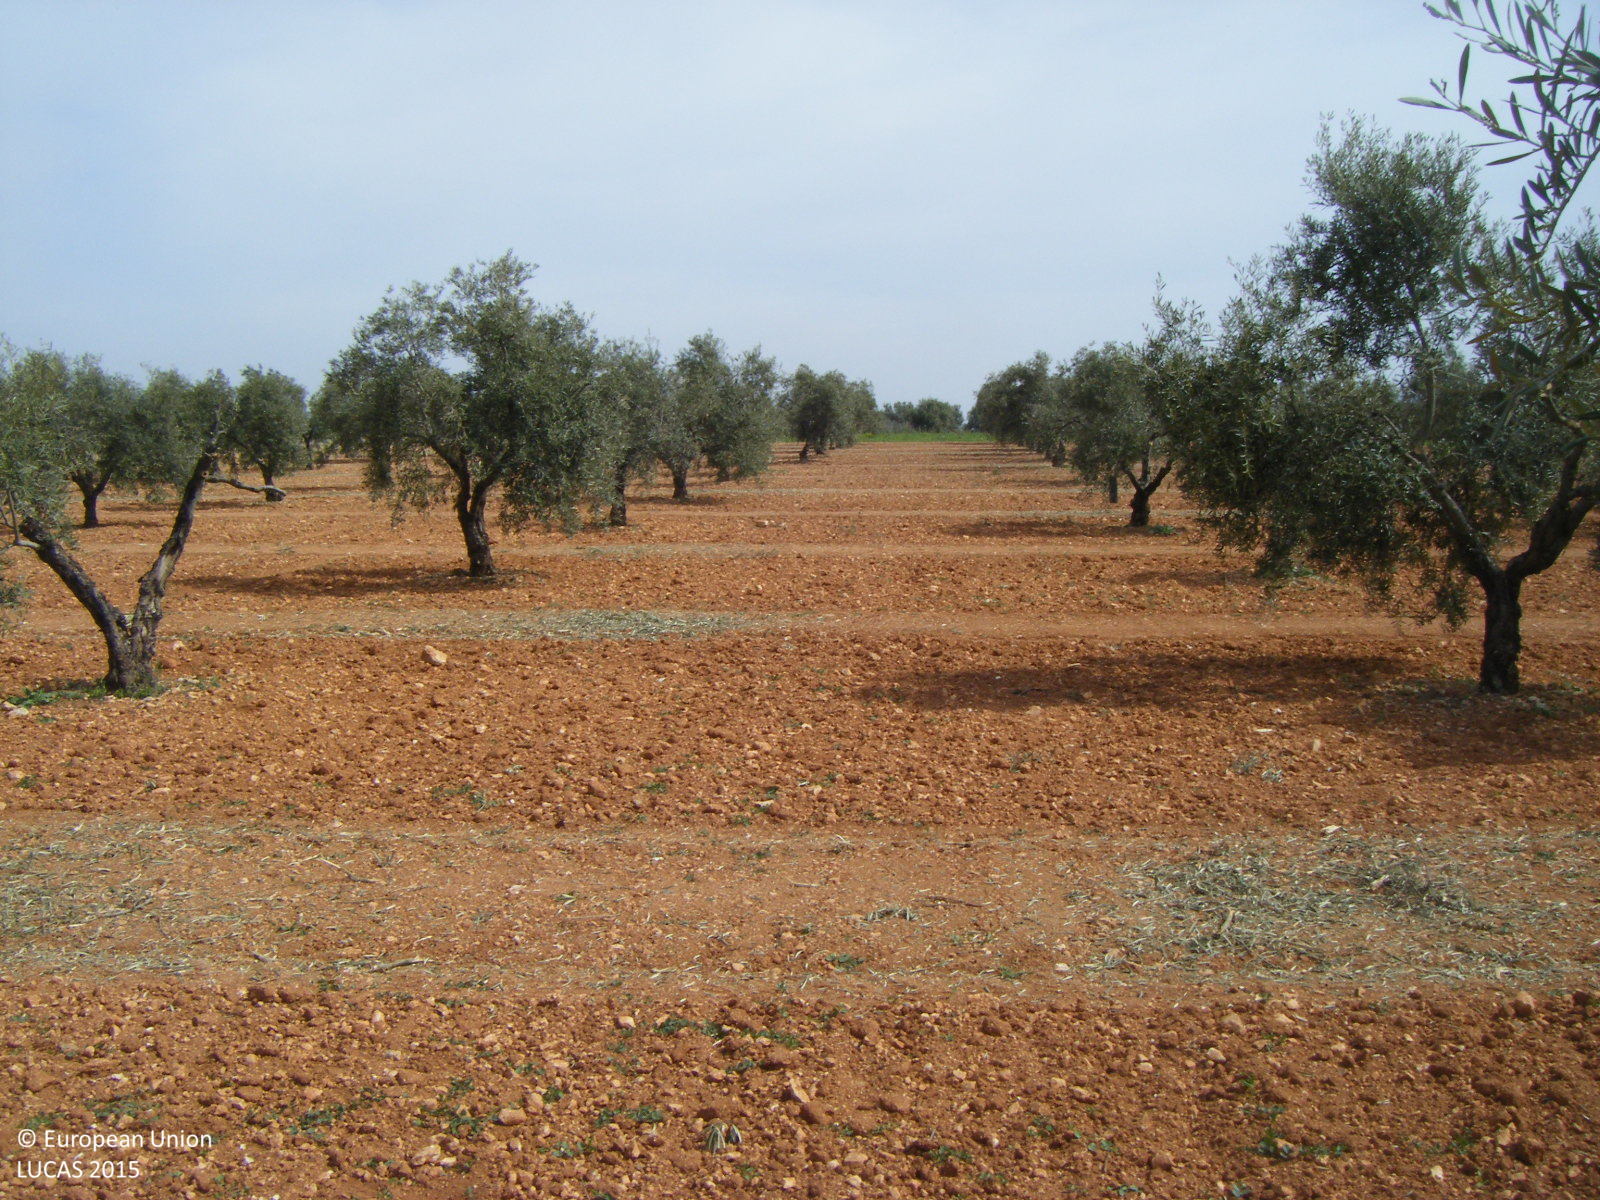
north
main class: Cropland
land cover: Olive groves
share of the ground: 10 - 25 %
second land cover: Other bare soil
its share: > 75 %
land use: Agriculture (excluding fallow land and kitchen gardens)
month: April
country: ES
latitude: 37.1052
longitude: -4.7527
